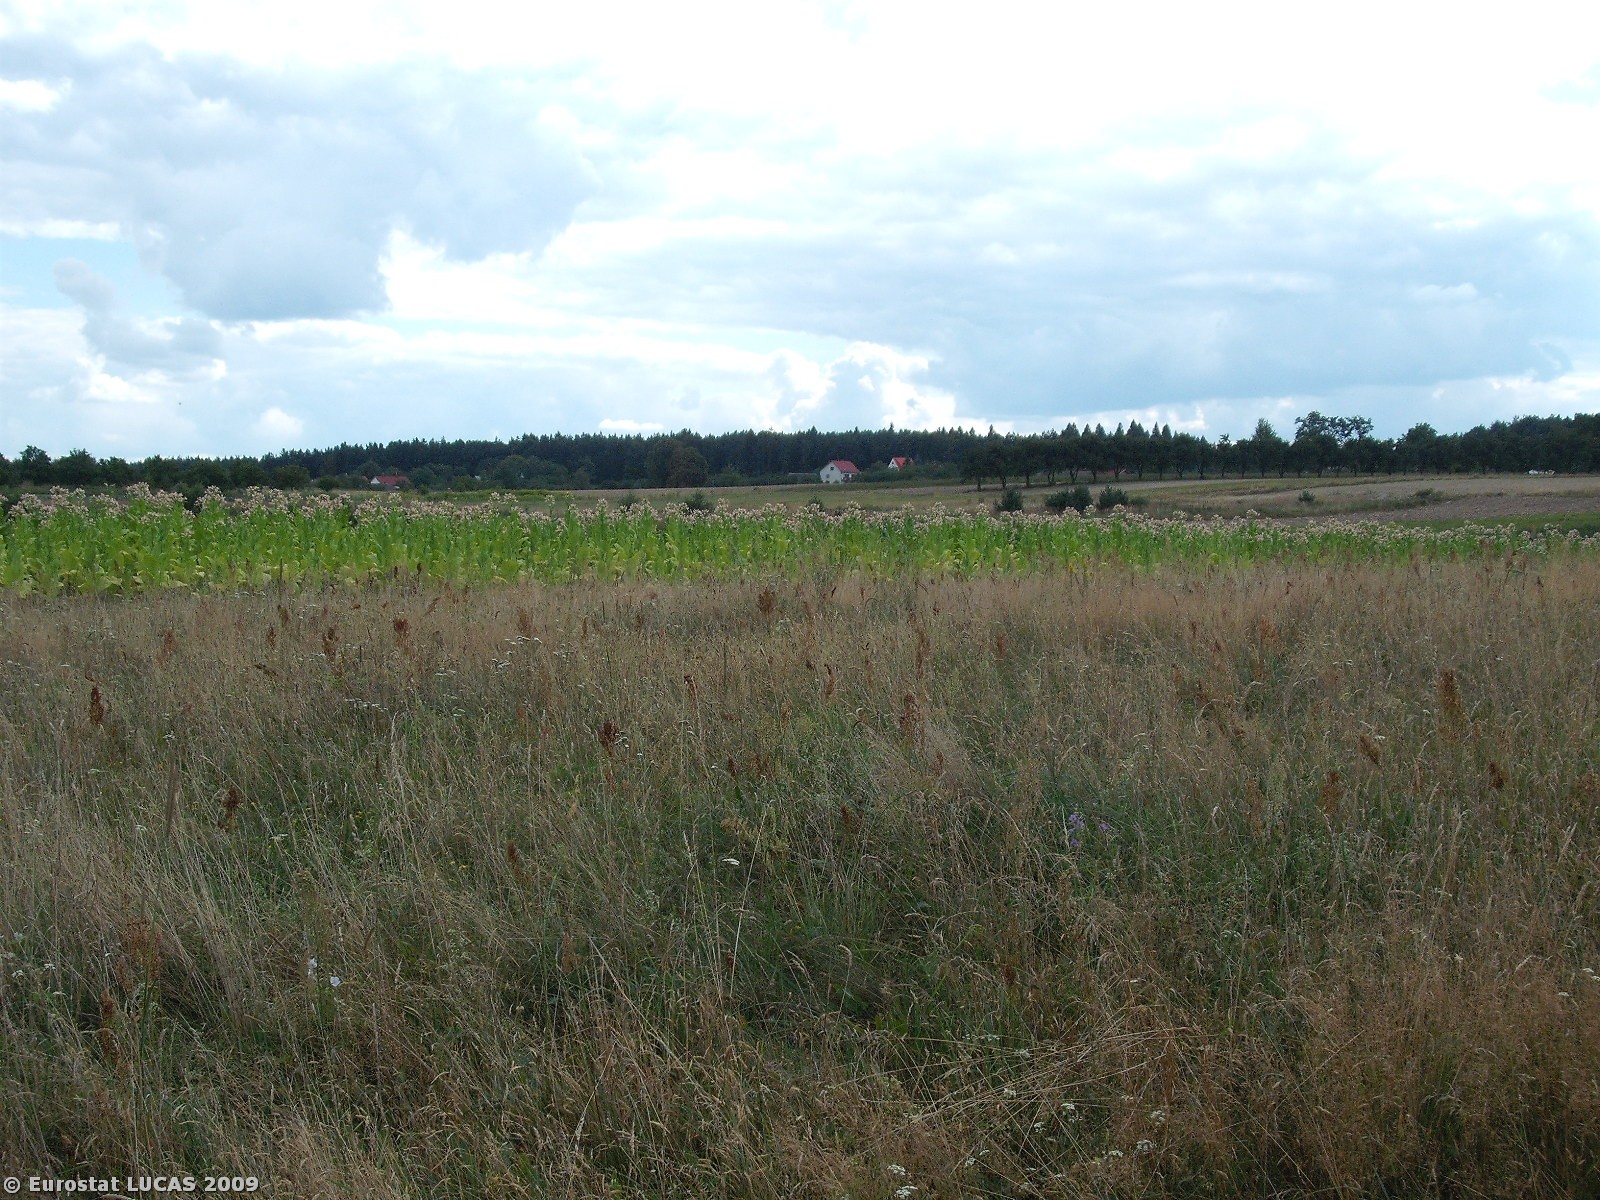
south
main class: Grassland
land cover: Grassland without tree/shrub cover
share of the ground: > 75 %
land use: Agriculture (excluding fallow land and kitchen gardens)
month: August
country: PL
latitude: 50.1774
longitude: 22.4004
